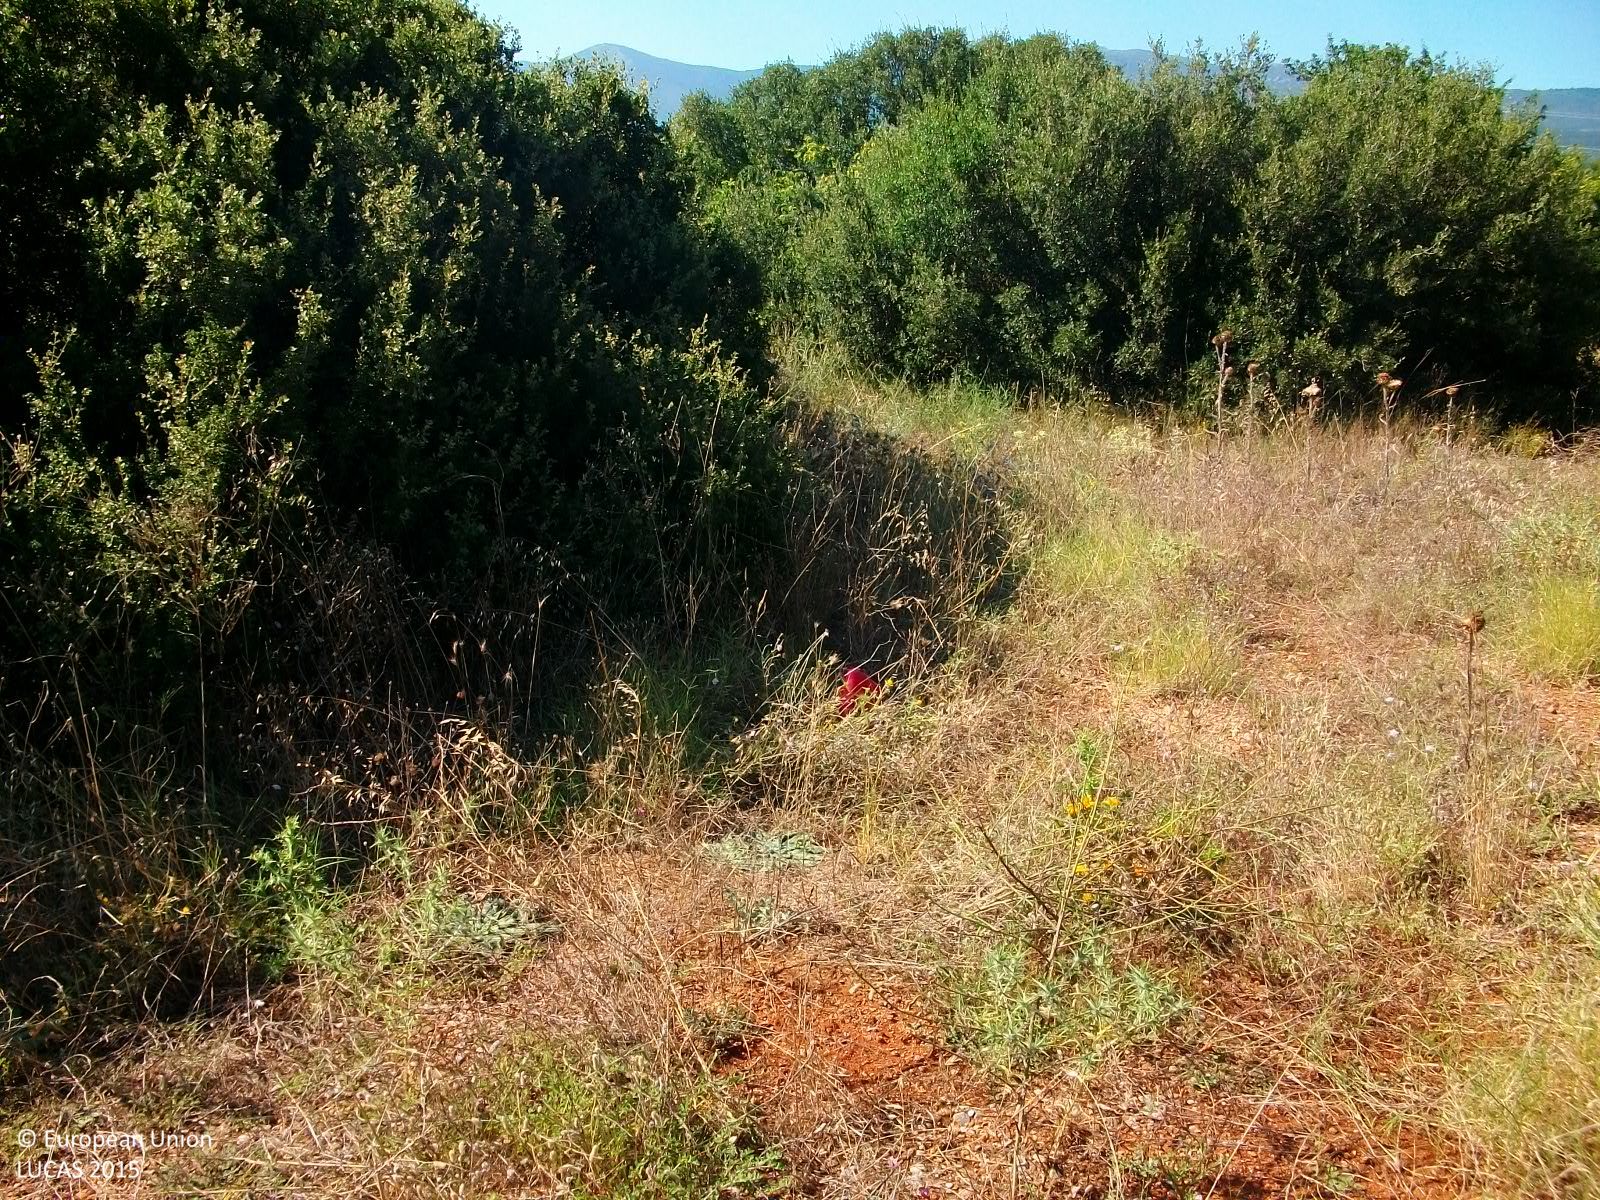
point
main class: Shrubland
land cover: Shrubland without tree cover
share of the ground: > 75 %
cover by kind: shrubs 90 %, herbaceous plants 10 %
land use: Semi-natural and natural areas not in use
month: July
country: GR
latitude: 38.6664
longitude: 22.5867
